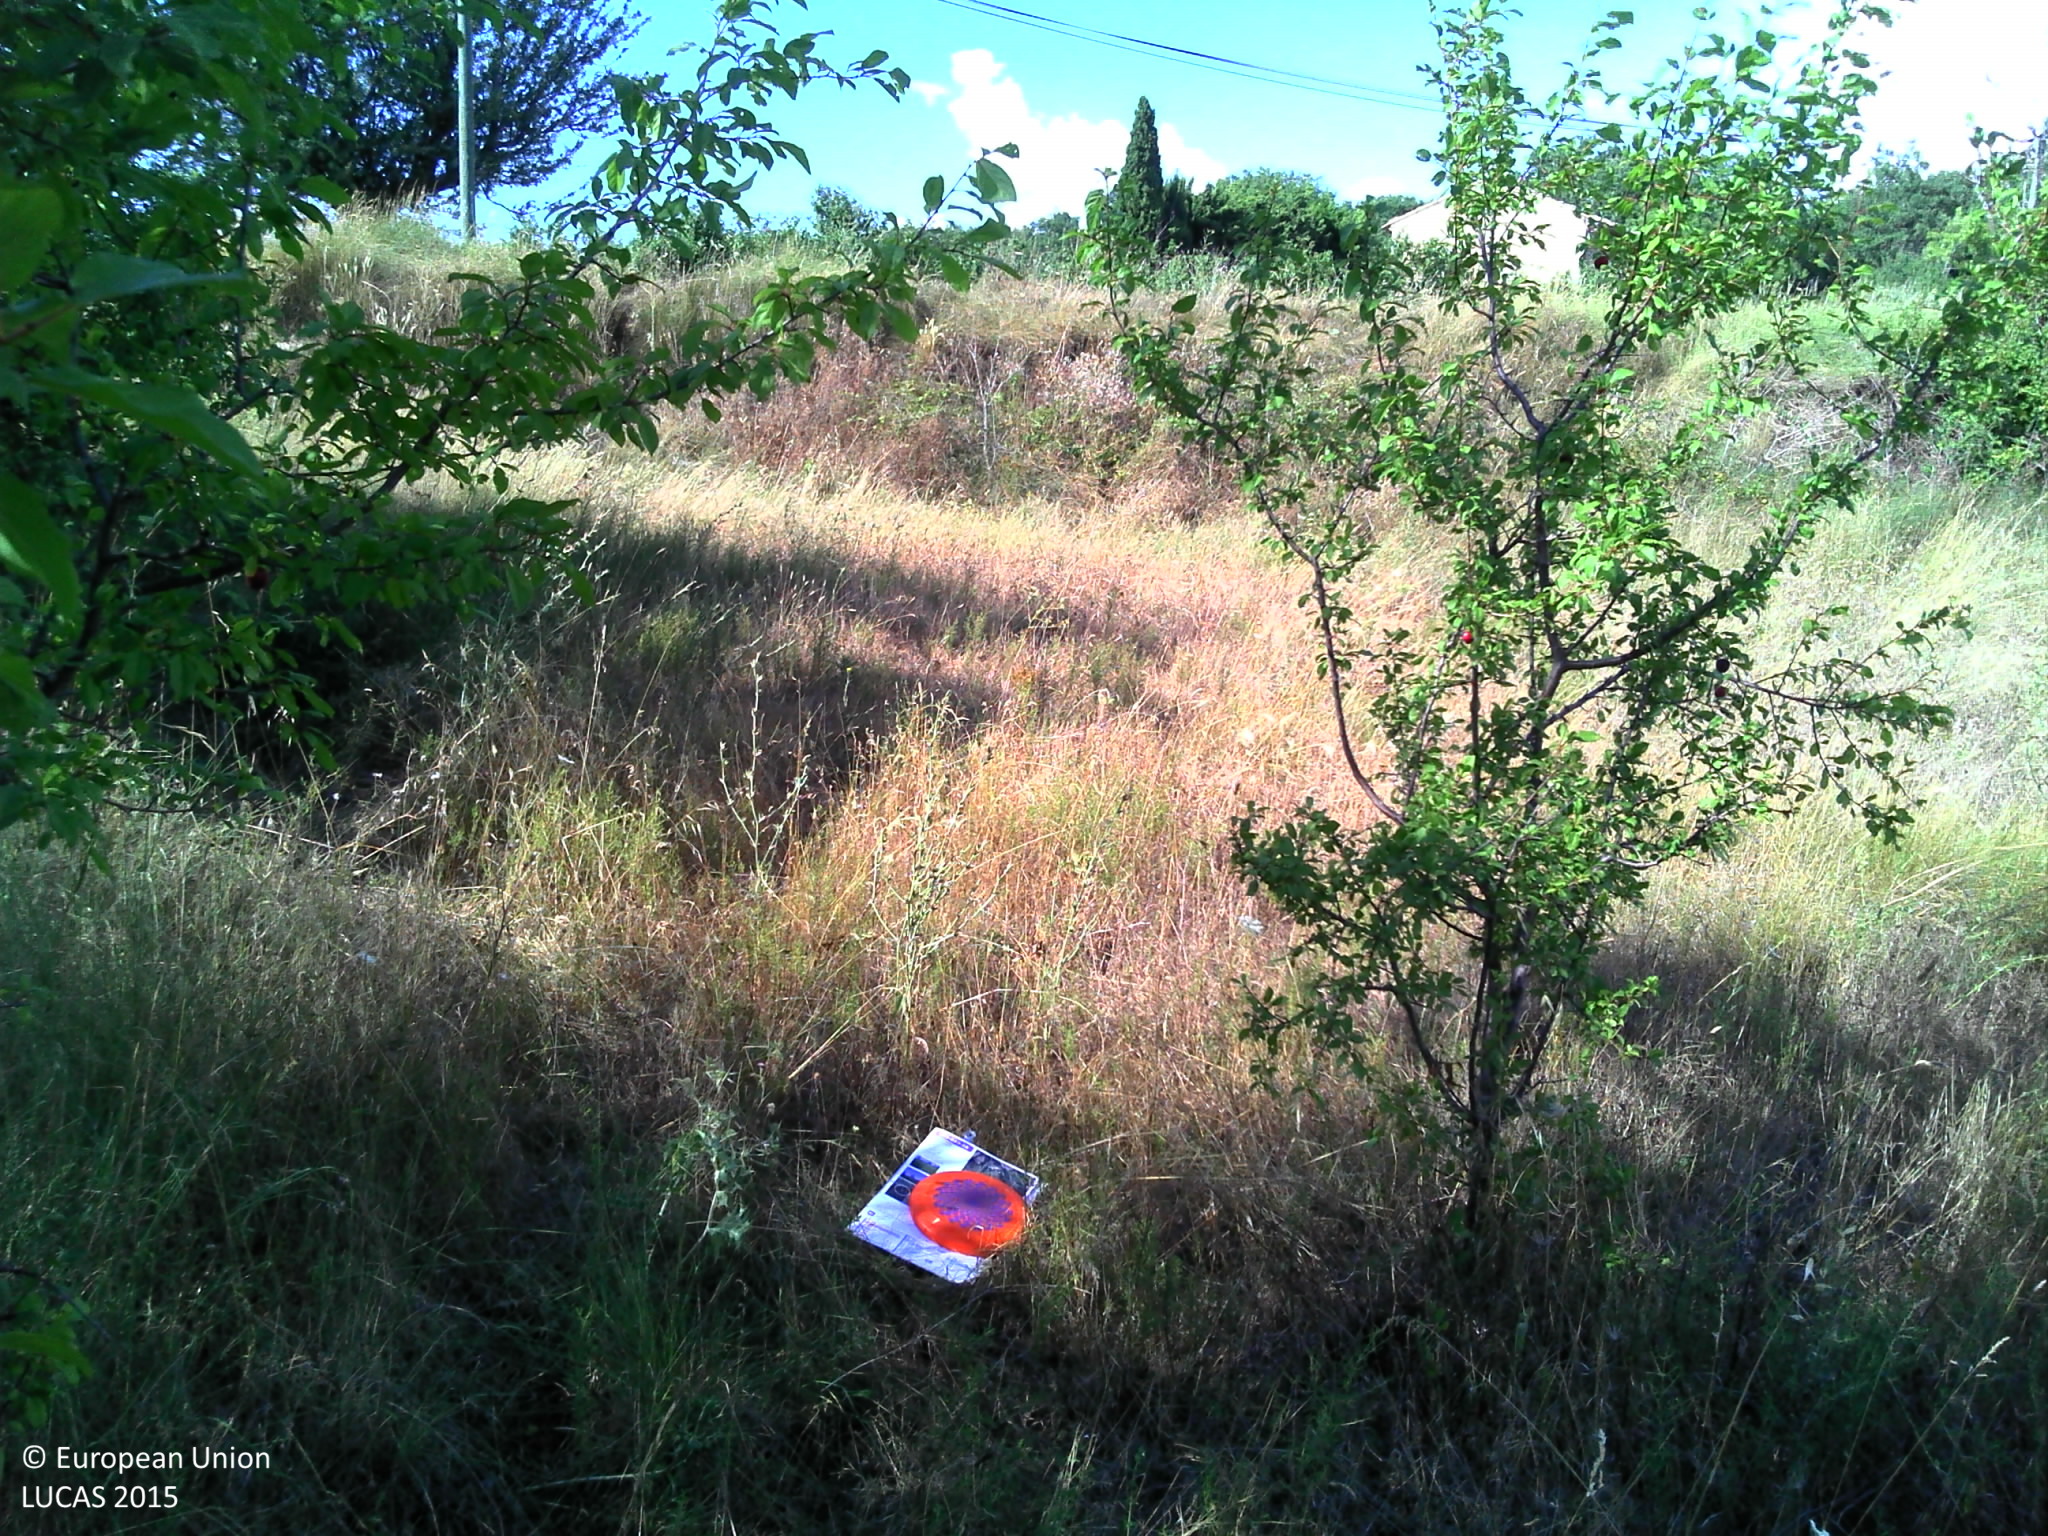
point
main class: Grassland
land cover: Grassland with sparse tree/shrub cover
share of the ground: > 75 %
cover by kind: herbaceous plants 90 %, broadleaved forest trees 5 %, shrubs 5 %
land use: Agriculture (excluding fallow land and kitchen gardens)
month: July
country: FR
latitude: 43.9521
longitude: 5.2360
